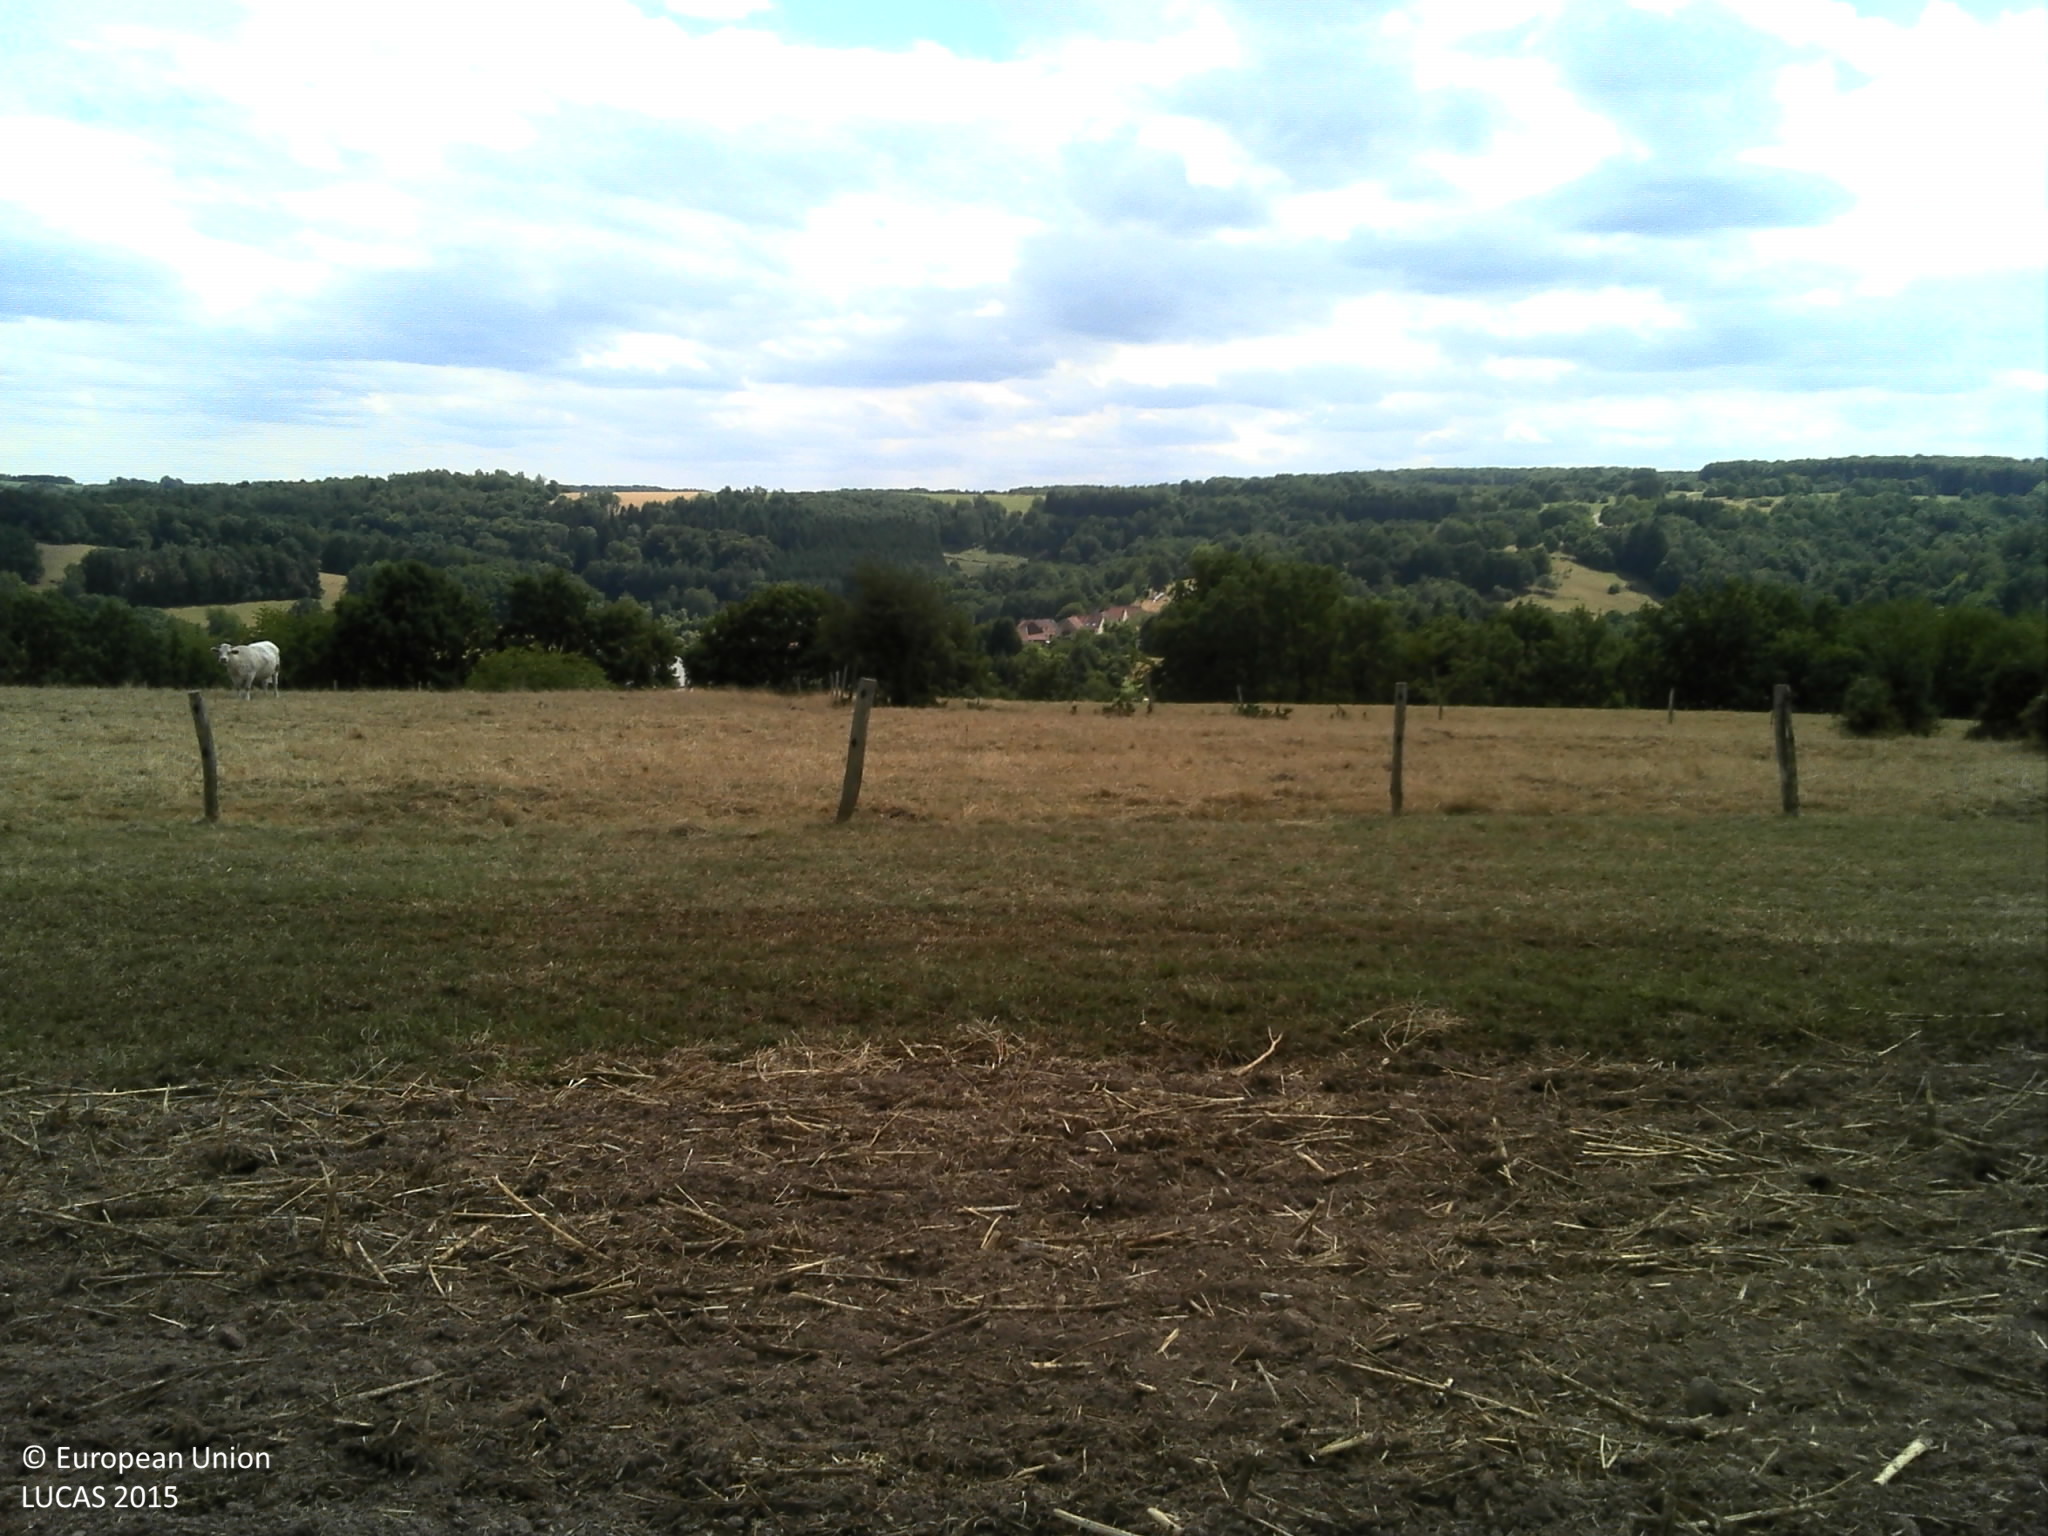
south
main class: Cropland
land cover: Rape and turnip rape
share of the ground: 10 - 25 %
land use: Agriculture (excluding fallow land and kitchen gardens)
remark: Harvested field
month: July
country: FR
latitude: 49.1484
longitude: 7.4642
